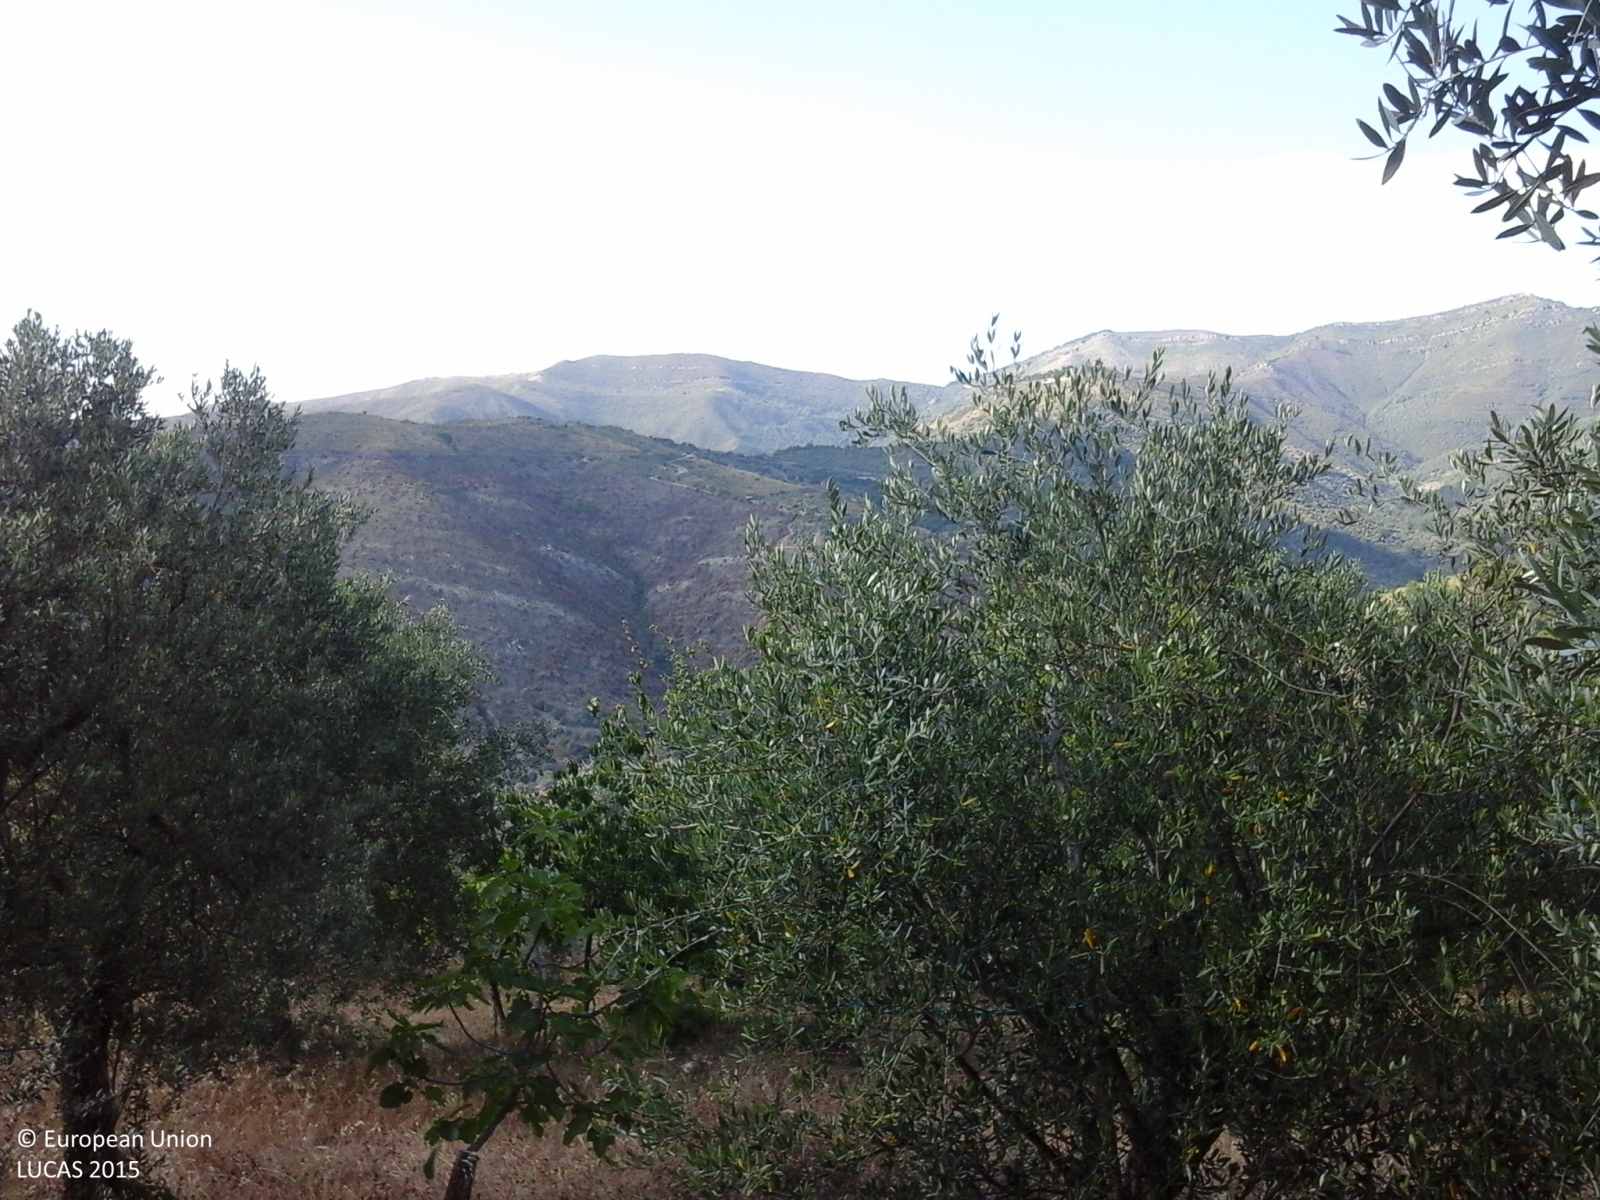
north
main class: Cropland
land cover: Olive groves
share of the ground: 50 - 75 %
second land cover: Other fruit trees and berries
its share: 10 - 25 %
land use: Agriculture (excluding fallow land and kitchen gardens)
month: June
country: IT
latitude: 40.2114
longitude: 15.0180
